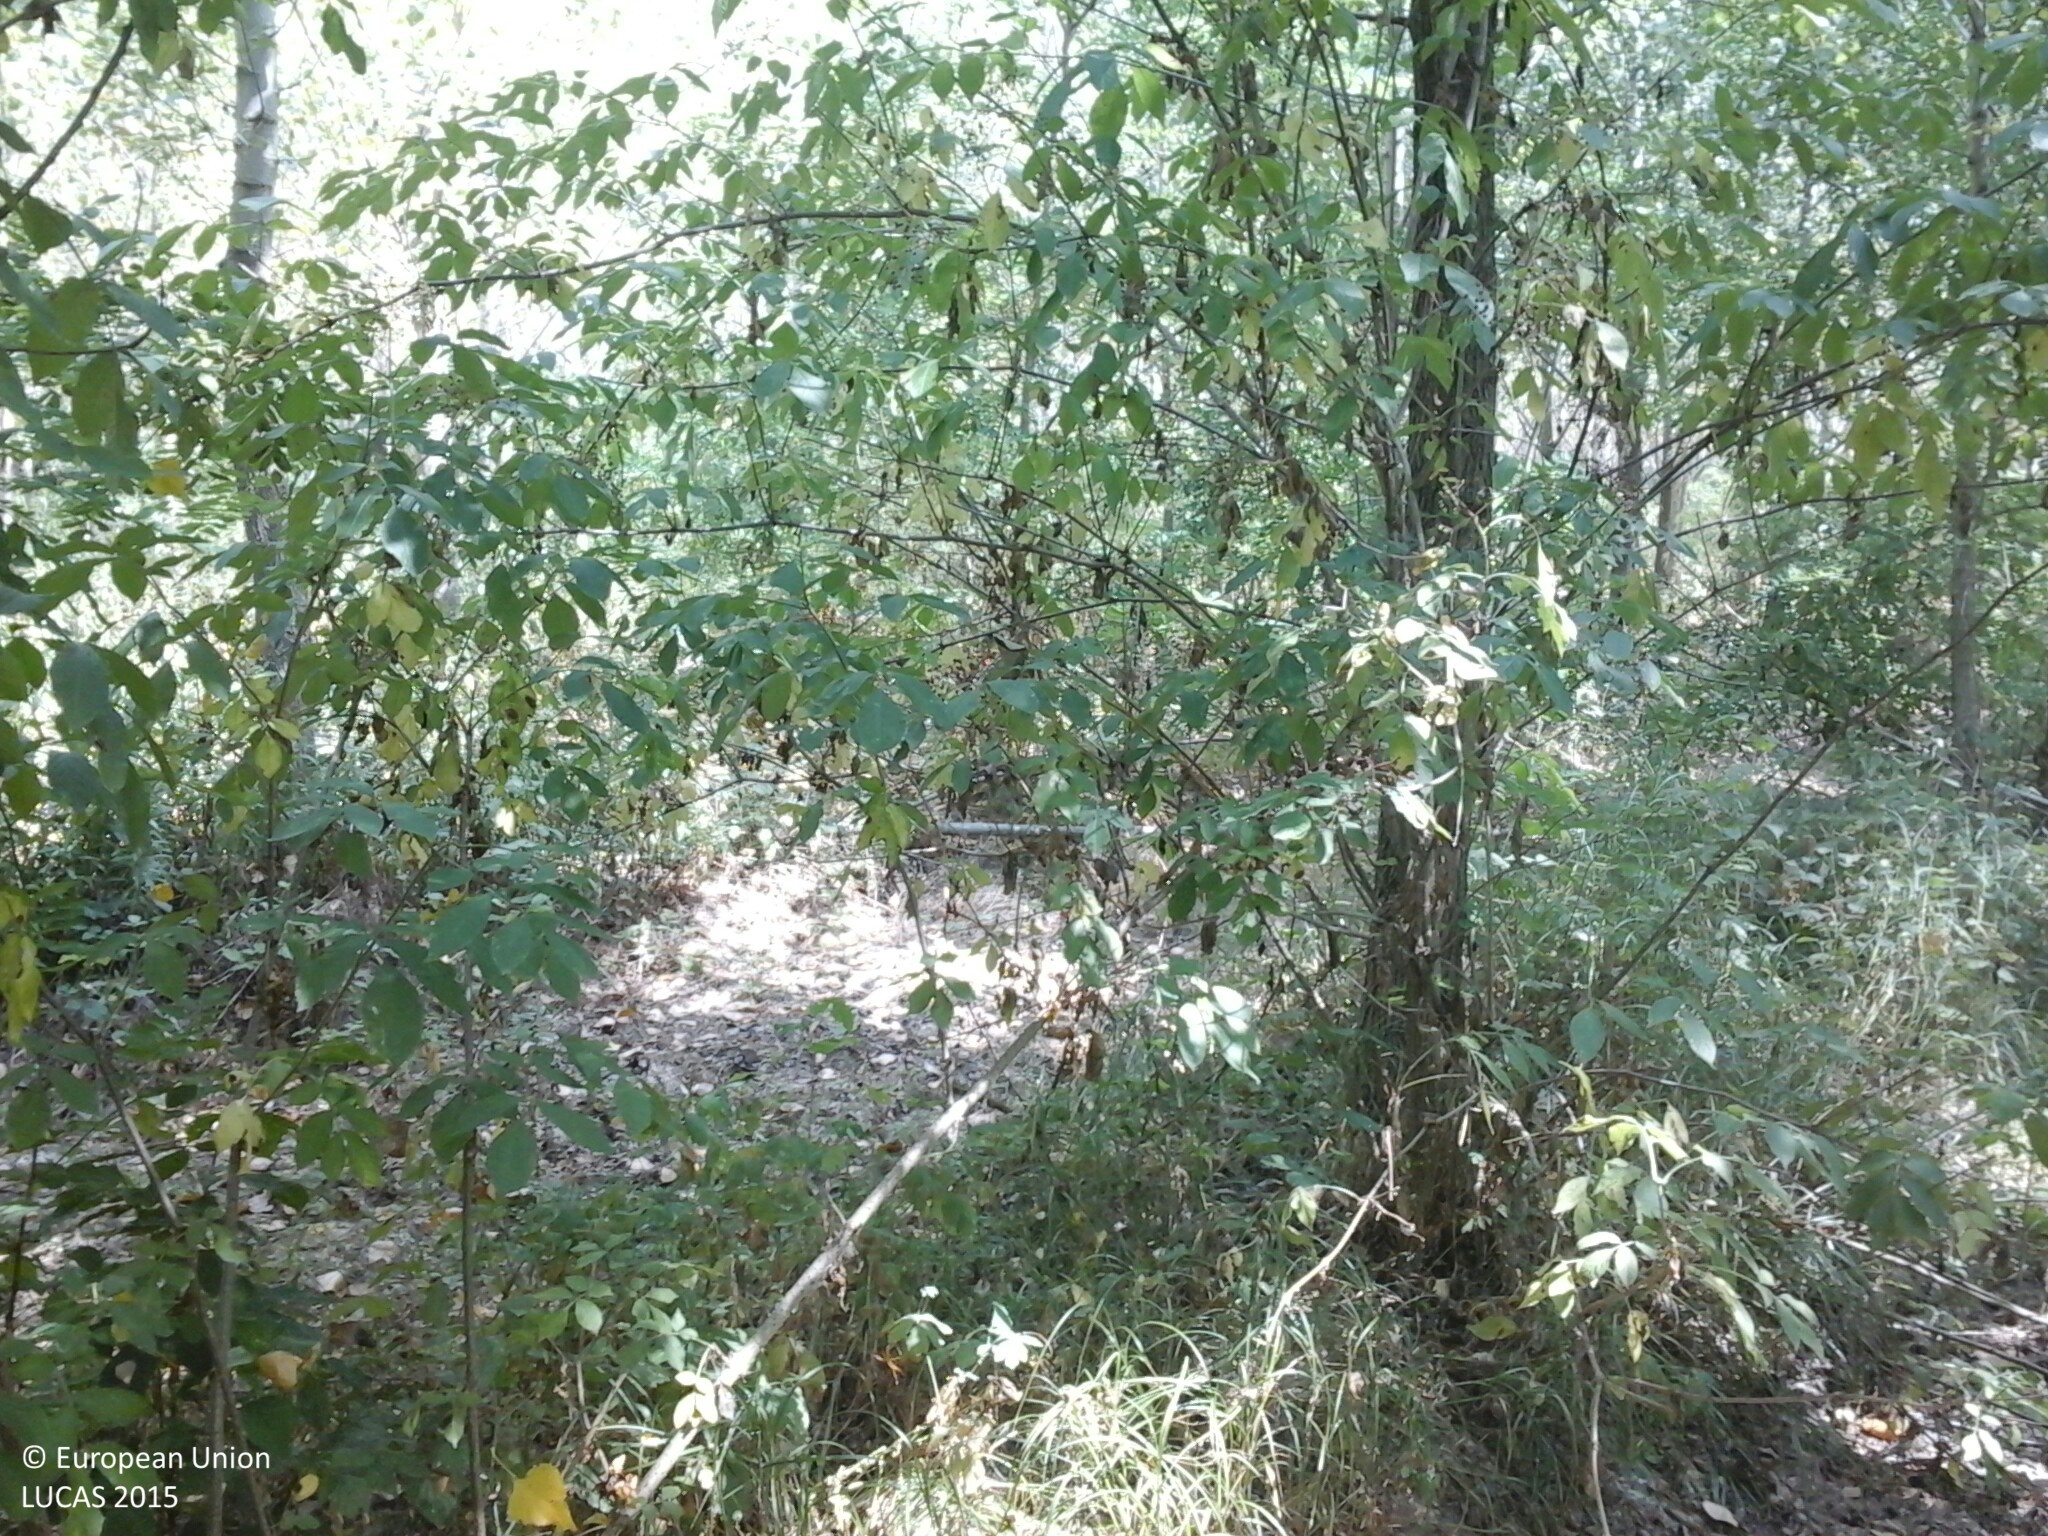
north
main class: Woodland
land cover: Broadleaved woodland
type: floodplain forest
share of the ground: > 75 %
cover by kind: broadleaved forest trees 100 %
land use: Forestry
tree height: > 5 m
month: July
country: HU
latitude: 48.3923
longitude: 22.2526
